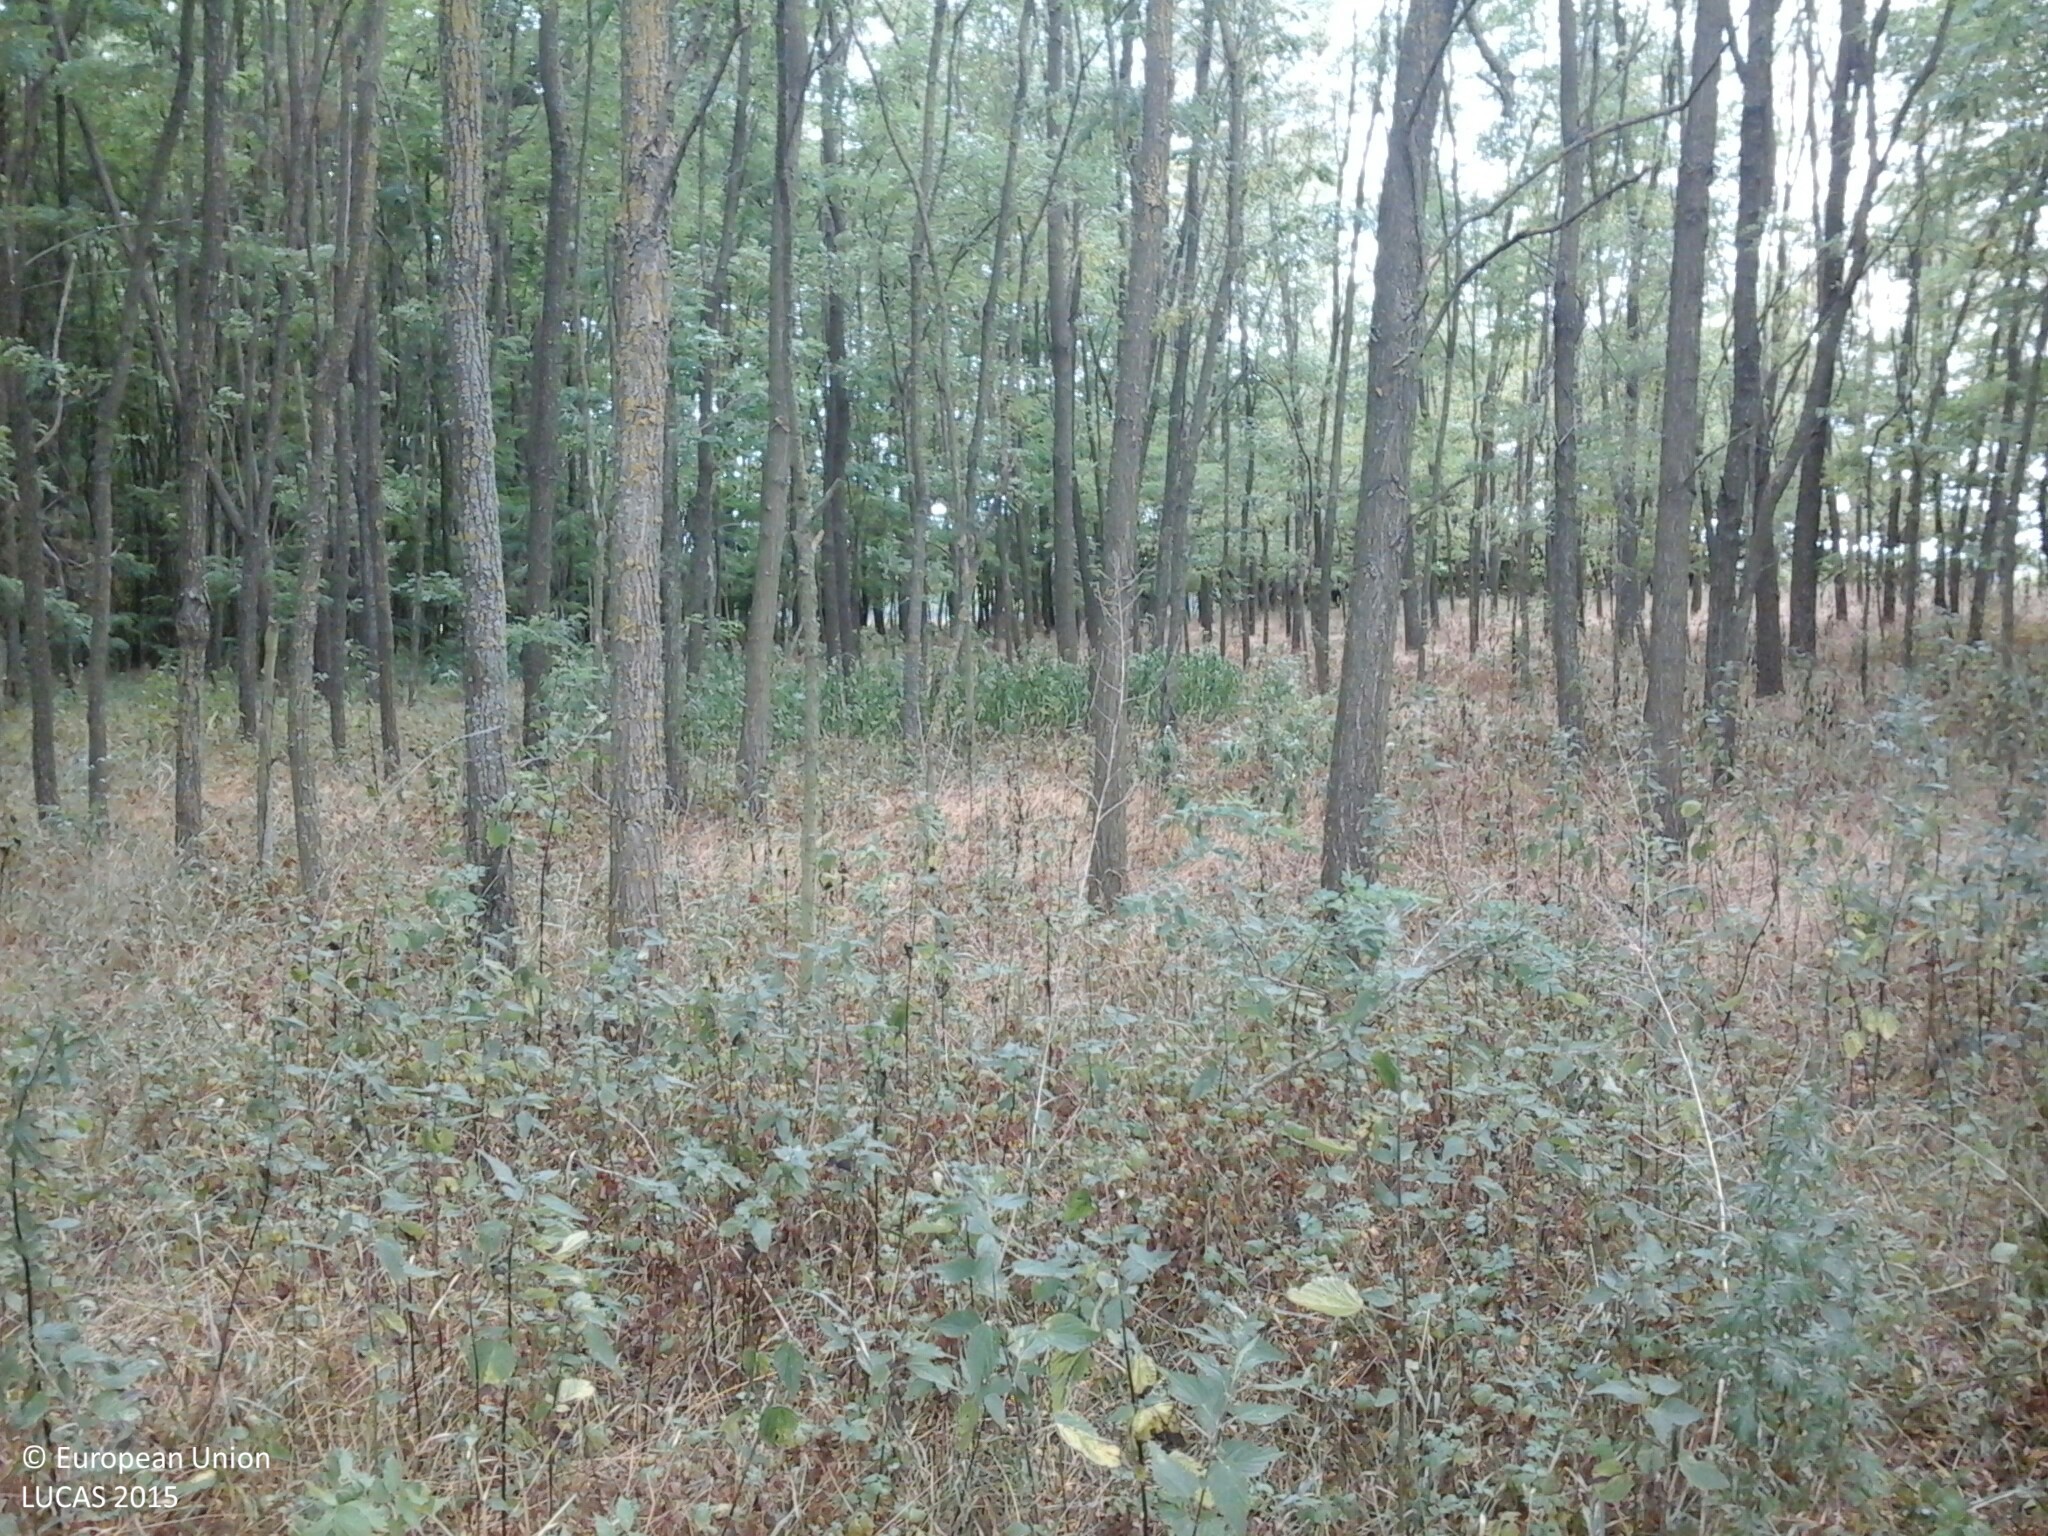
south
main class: Woodland
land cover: Broadleaved woodland
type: mesophytic deciduous forest
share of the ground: > 75 %
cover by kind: broadleaved forest trees 90 %, herbaceous plants 10 %
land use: Forestry
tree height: > 5 m
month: July
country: HU
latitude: 48.3628
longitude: 22.0261
